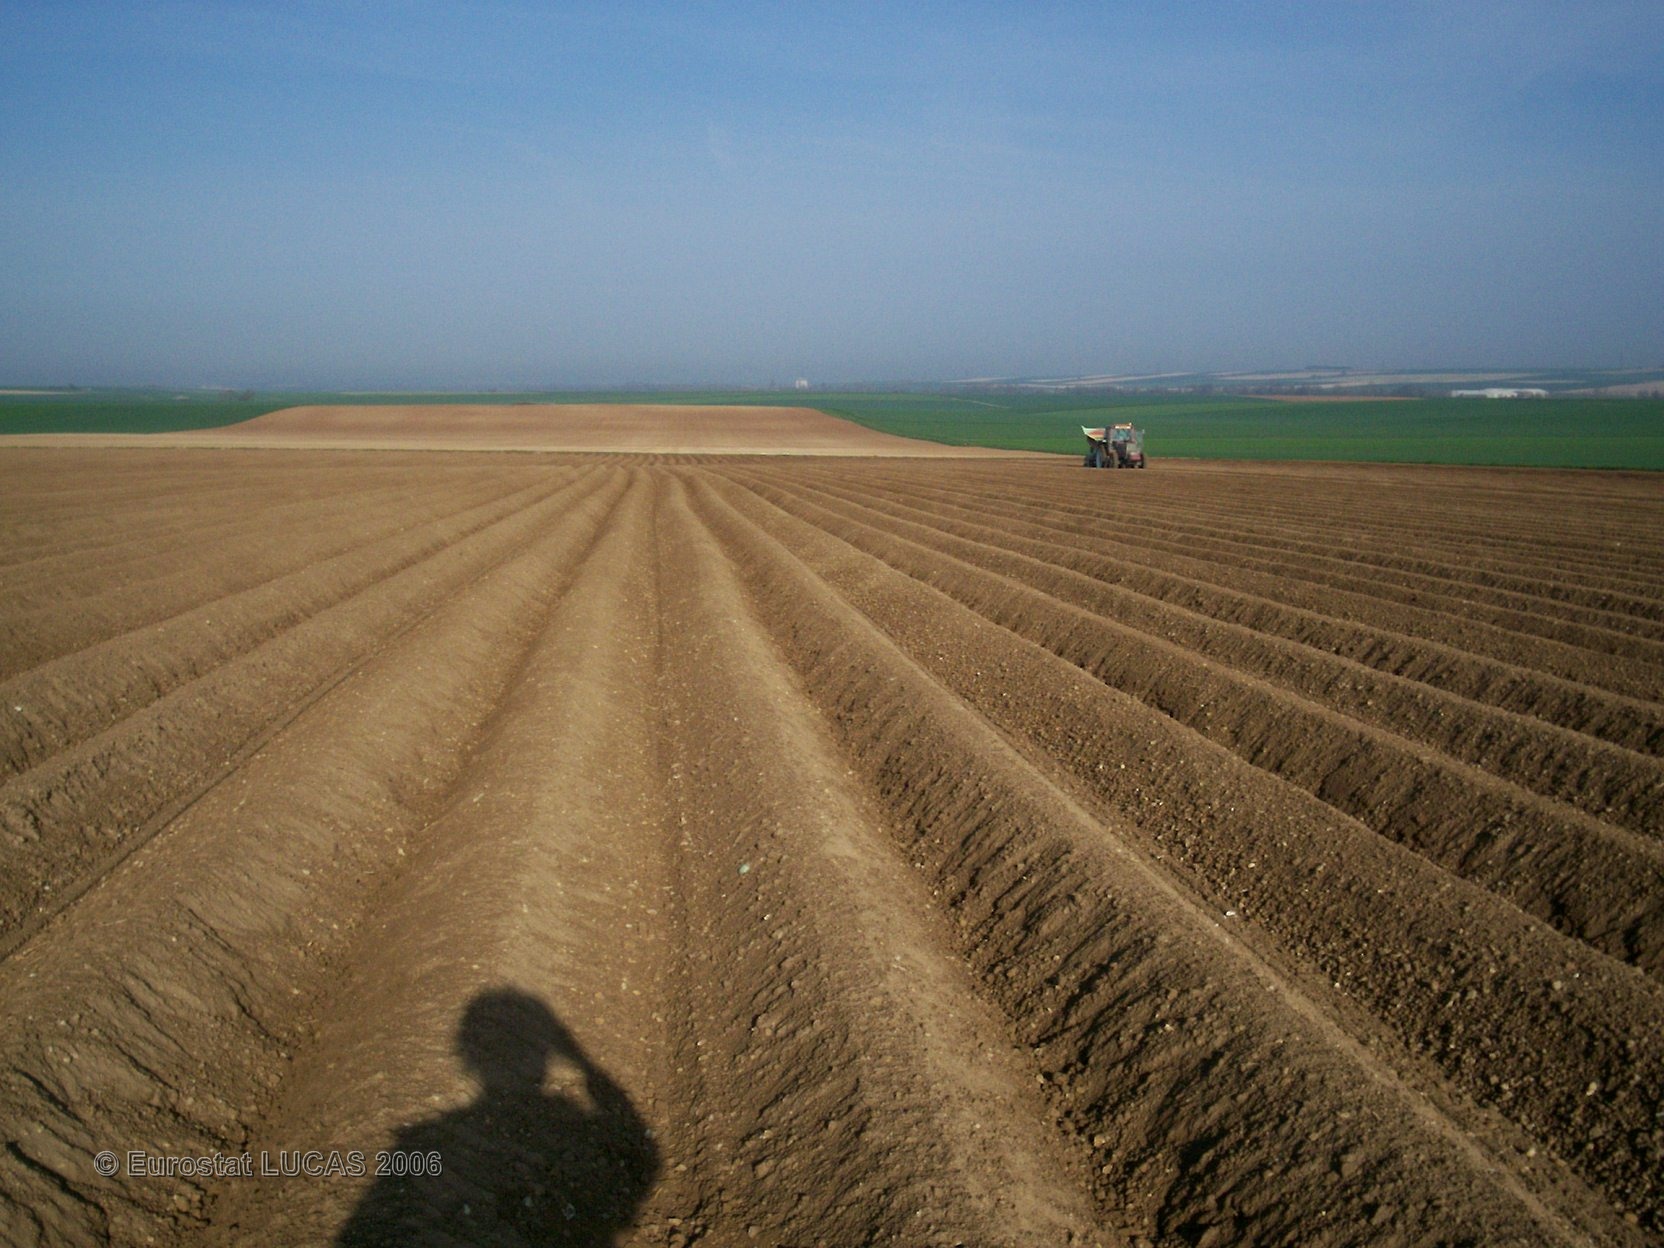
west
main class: Cropland
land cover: Potatoes
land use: Agriculture (excluding fallow land and kitchen gardens)
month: April
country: FR
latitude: 48.4620
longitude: 4.4389
